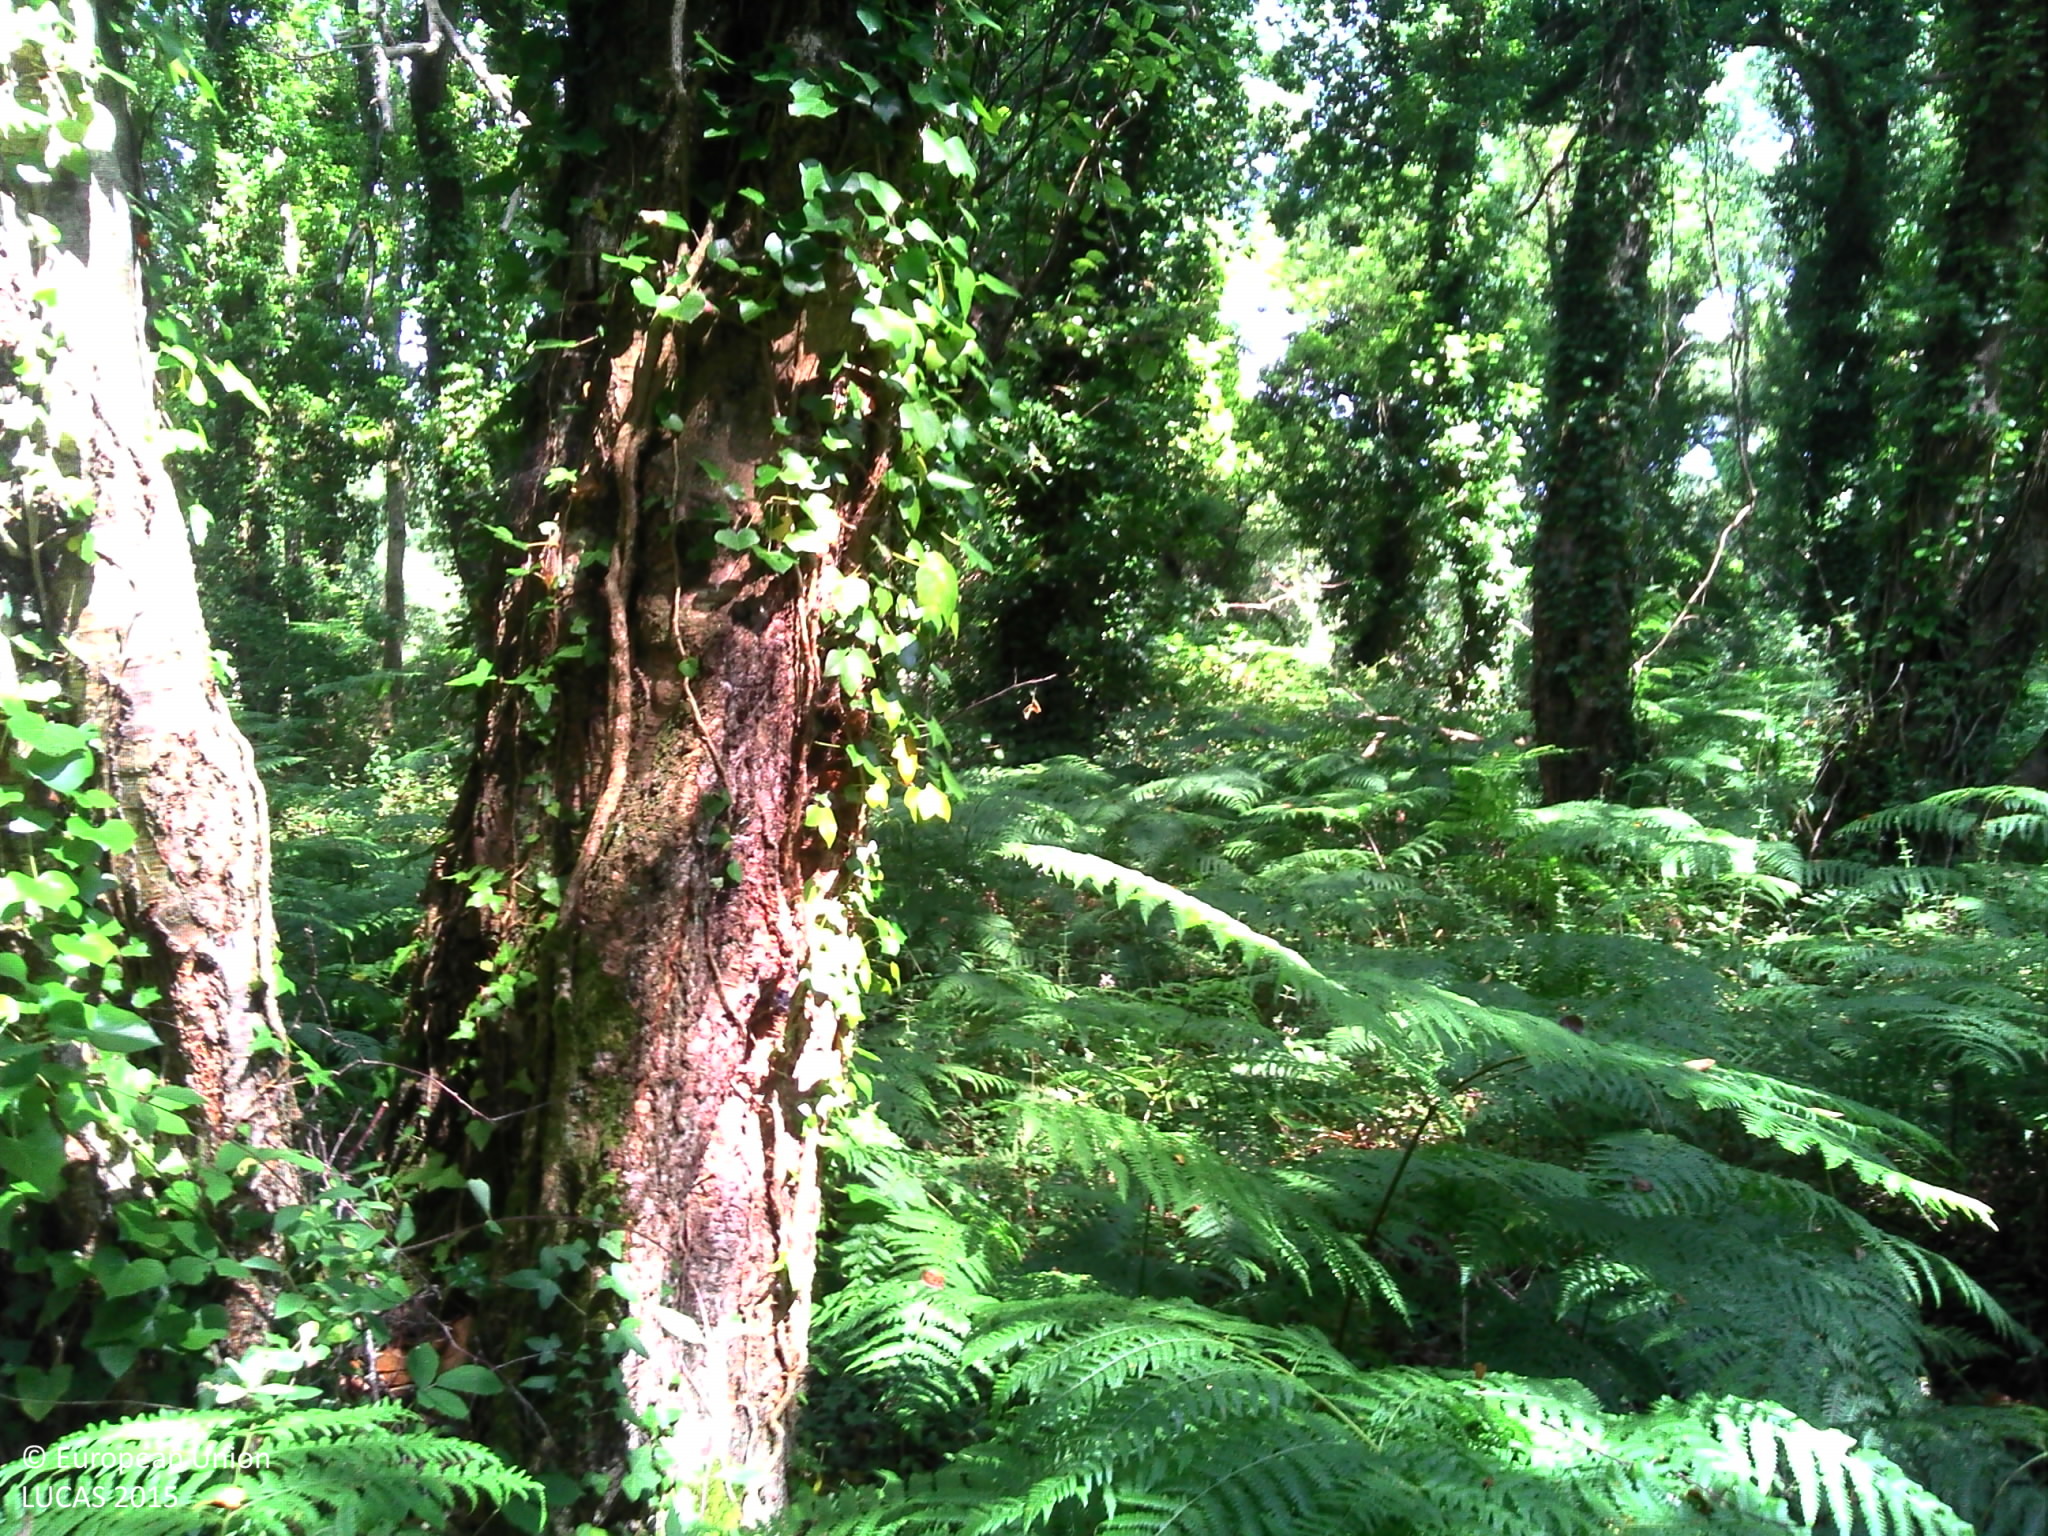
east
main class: Woodland
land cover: Broadleaved woodland
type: mesophytic deciduous forest
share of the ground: > 75 %
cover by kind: herbaceous plants 80 %, broadleaved forest trees 20 %
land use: Forestry
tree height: > 5 m
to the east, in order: Broadleaved woodland; Grassland without tree/shrub cover; Broadleaved woodland; Shrubland without tree cover; Grassland with sparse tree/shrub cover; Broadleaved woodland
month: July
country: FR
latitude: 48.7911
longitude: -3.5153
